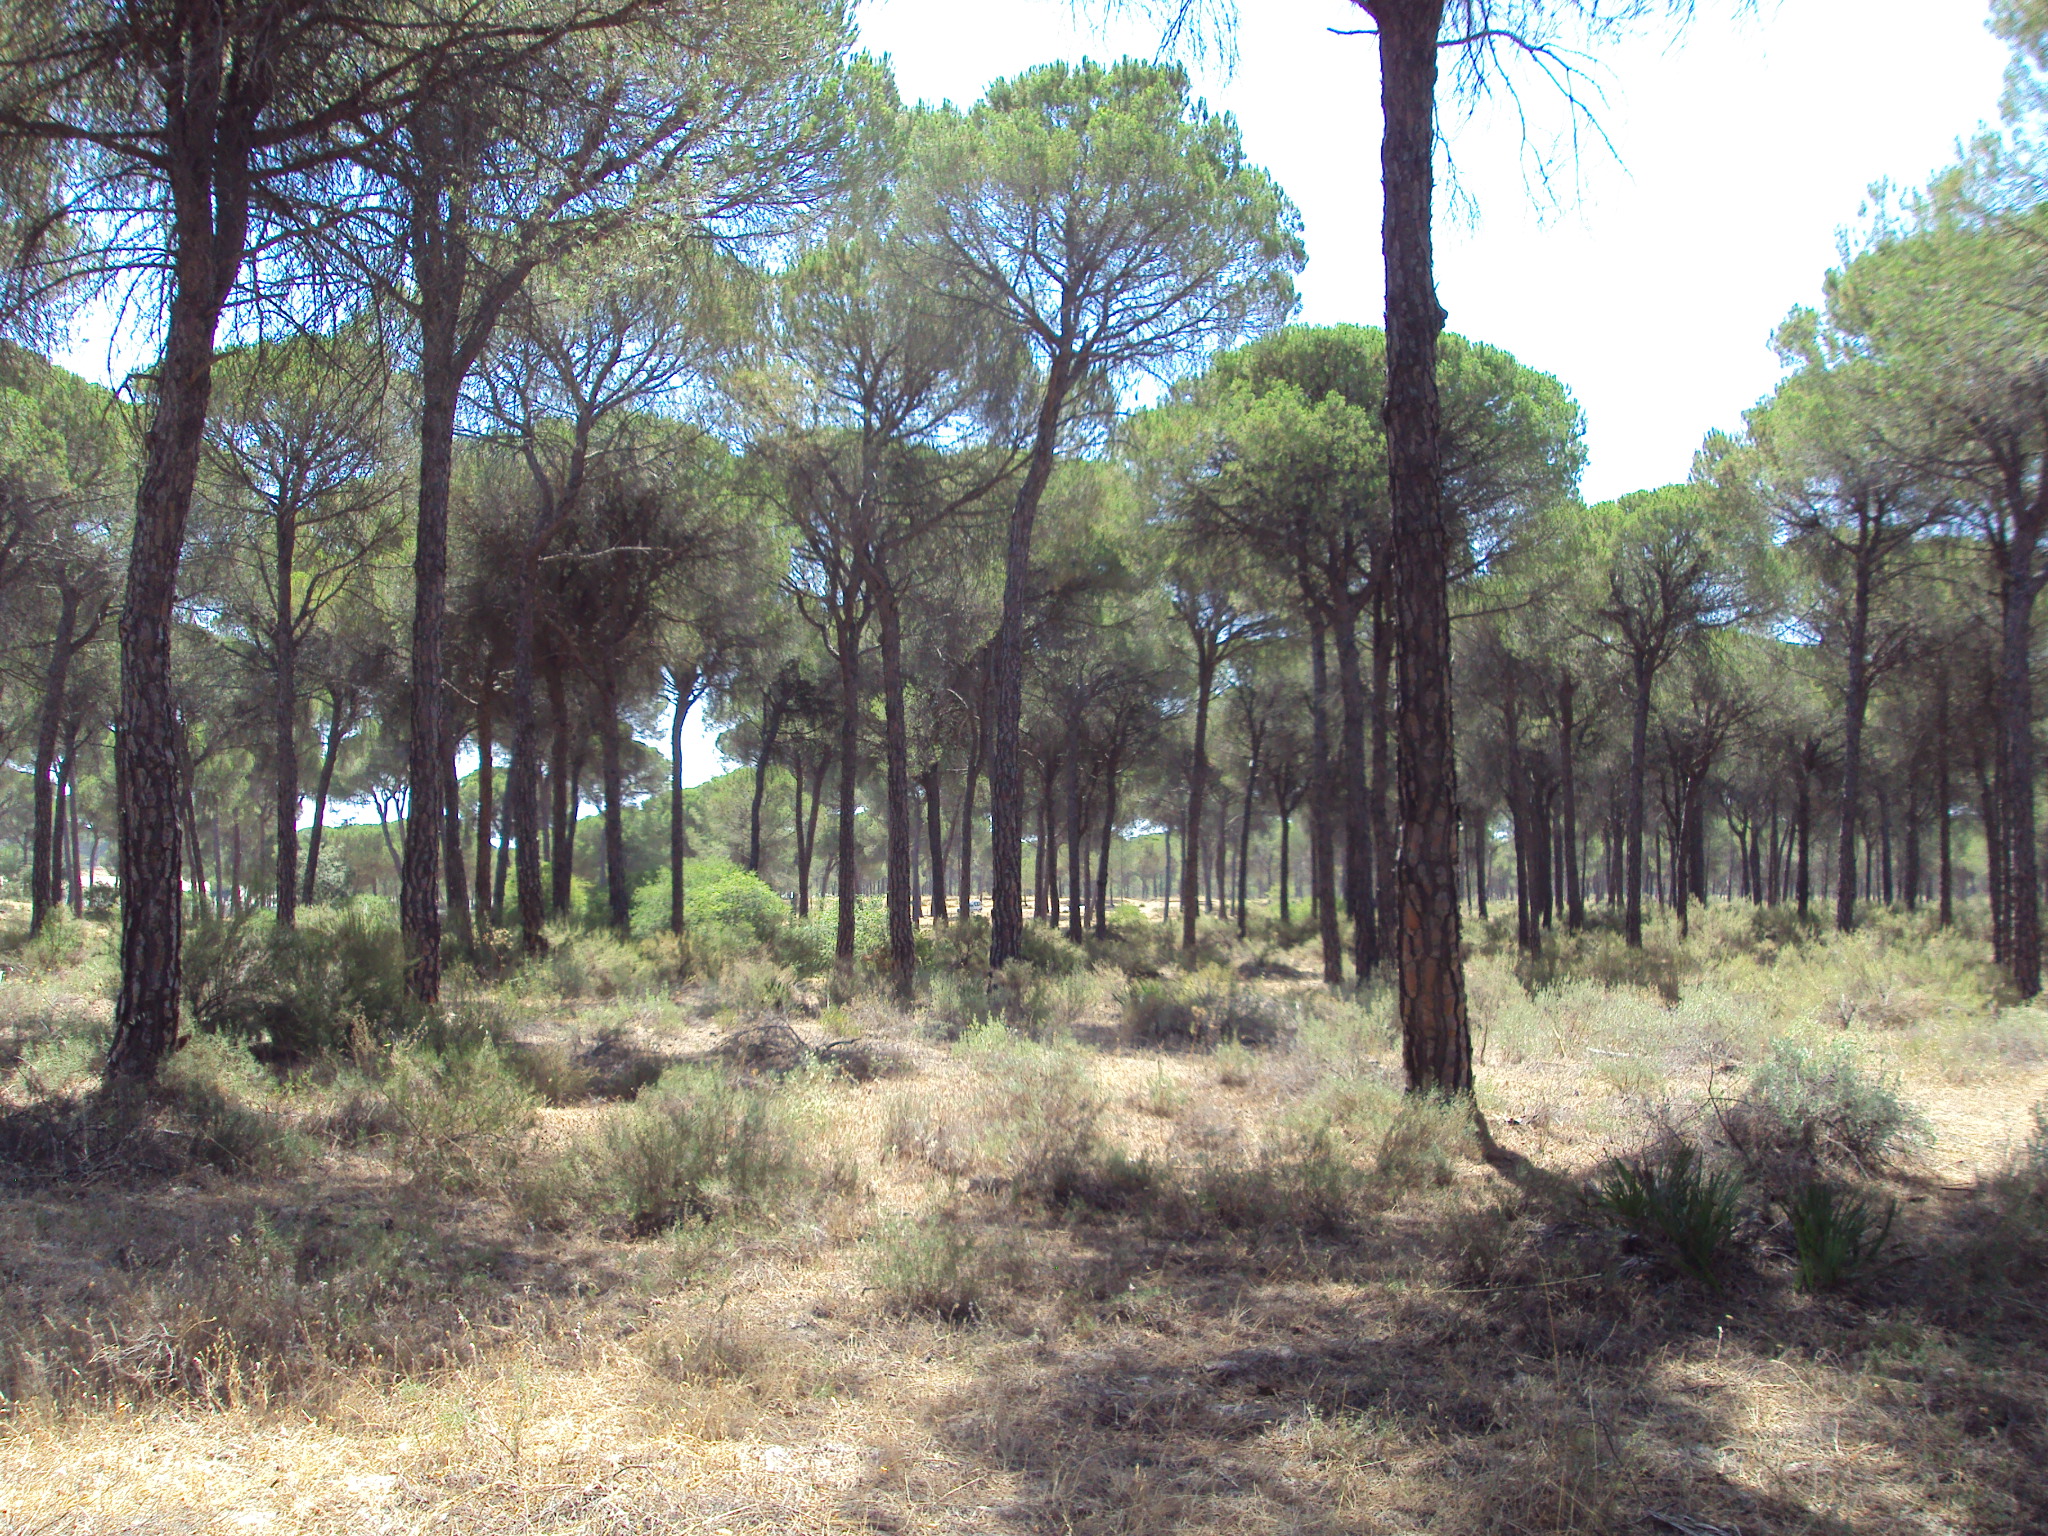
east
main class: Woodland
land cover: Pine dominated coniferous woodland
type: coniferous forest of the mediterranean region
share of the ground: 50 - 75 %
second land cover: Spontaneously vegetated surfaces
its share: > 75 %
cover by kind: coniferous forest trees 60 %, shrubs 30 %, herbaceous plants 10 %
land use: Forestry
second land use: Agriculture (excluding fallow land and kitchen gardens)
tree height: > 5 m
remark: Clear cut
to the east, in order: Pine dominated coniferous woodland; Spontaneously vegetated surfaces; Other structural elements; Fences; Grass margins; Tracks; Ditches and canals; Grass margins; Pine dominated coniferous woodland; Other structural elements; Pine dominated coniferous woodland
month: July
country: ES
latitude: 37.2255
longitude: -6.5640
